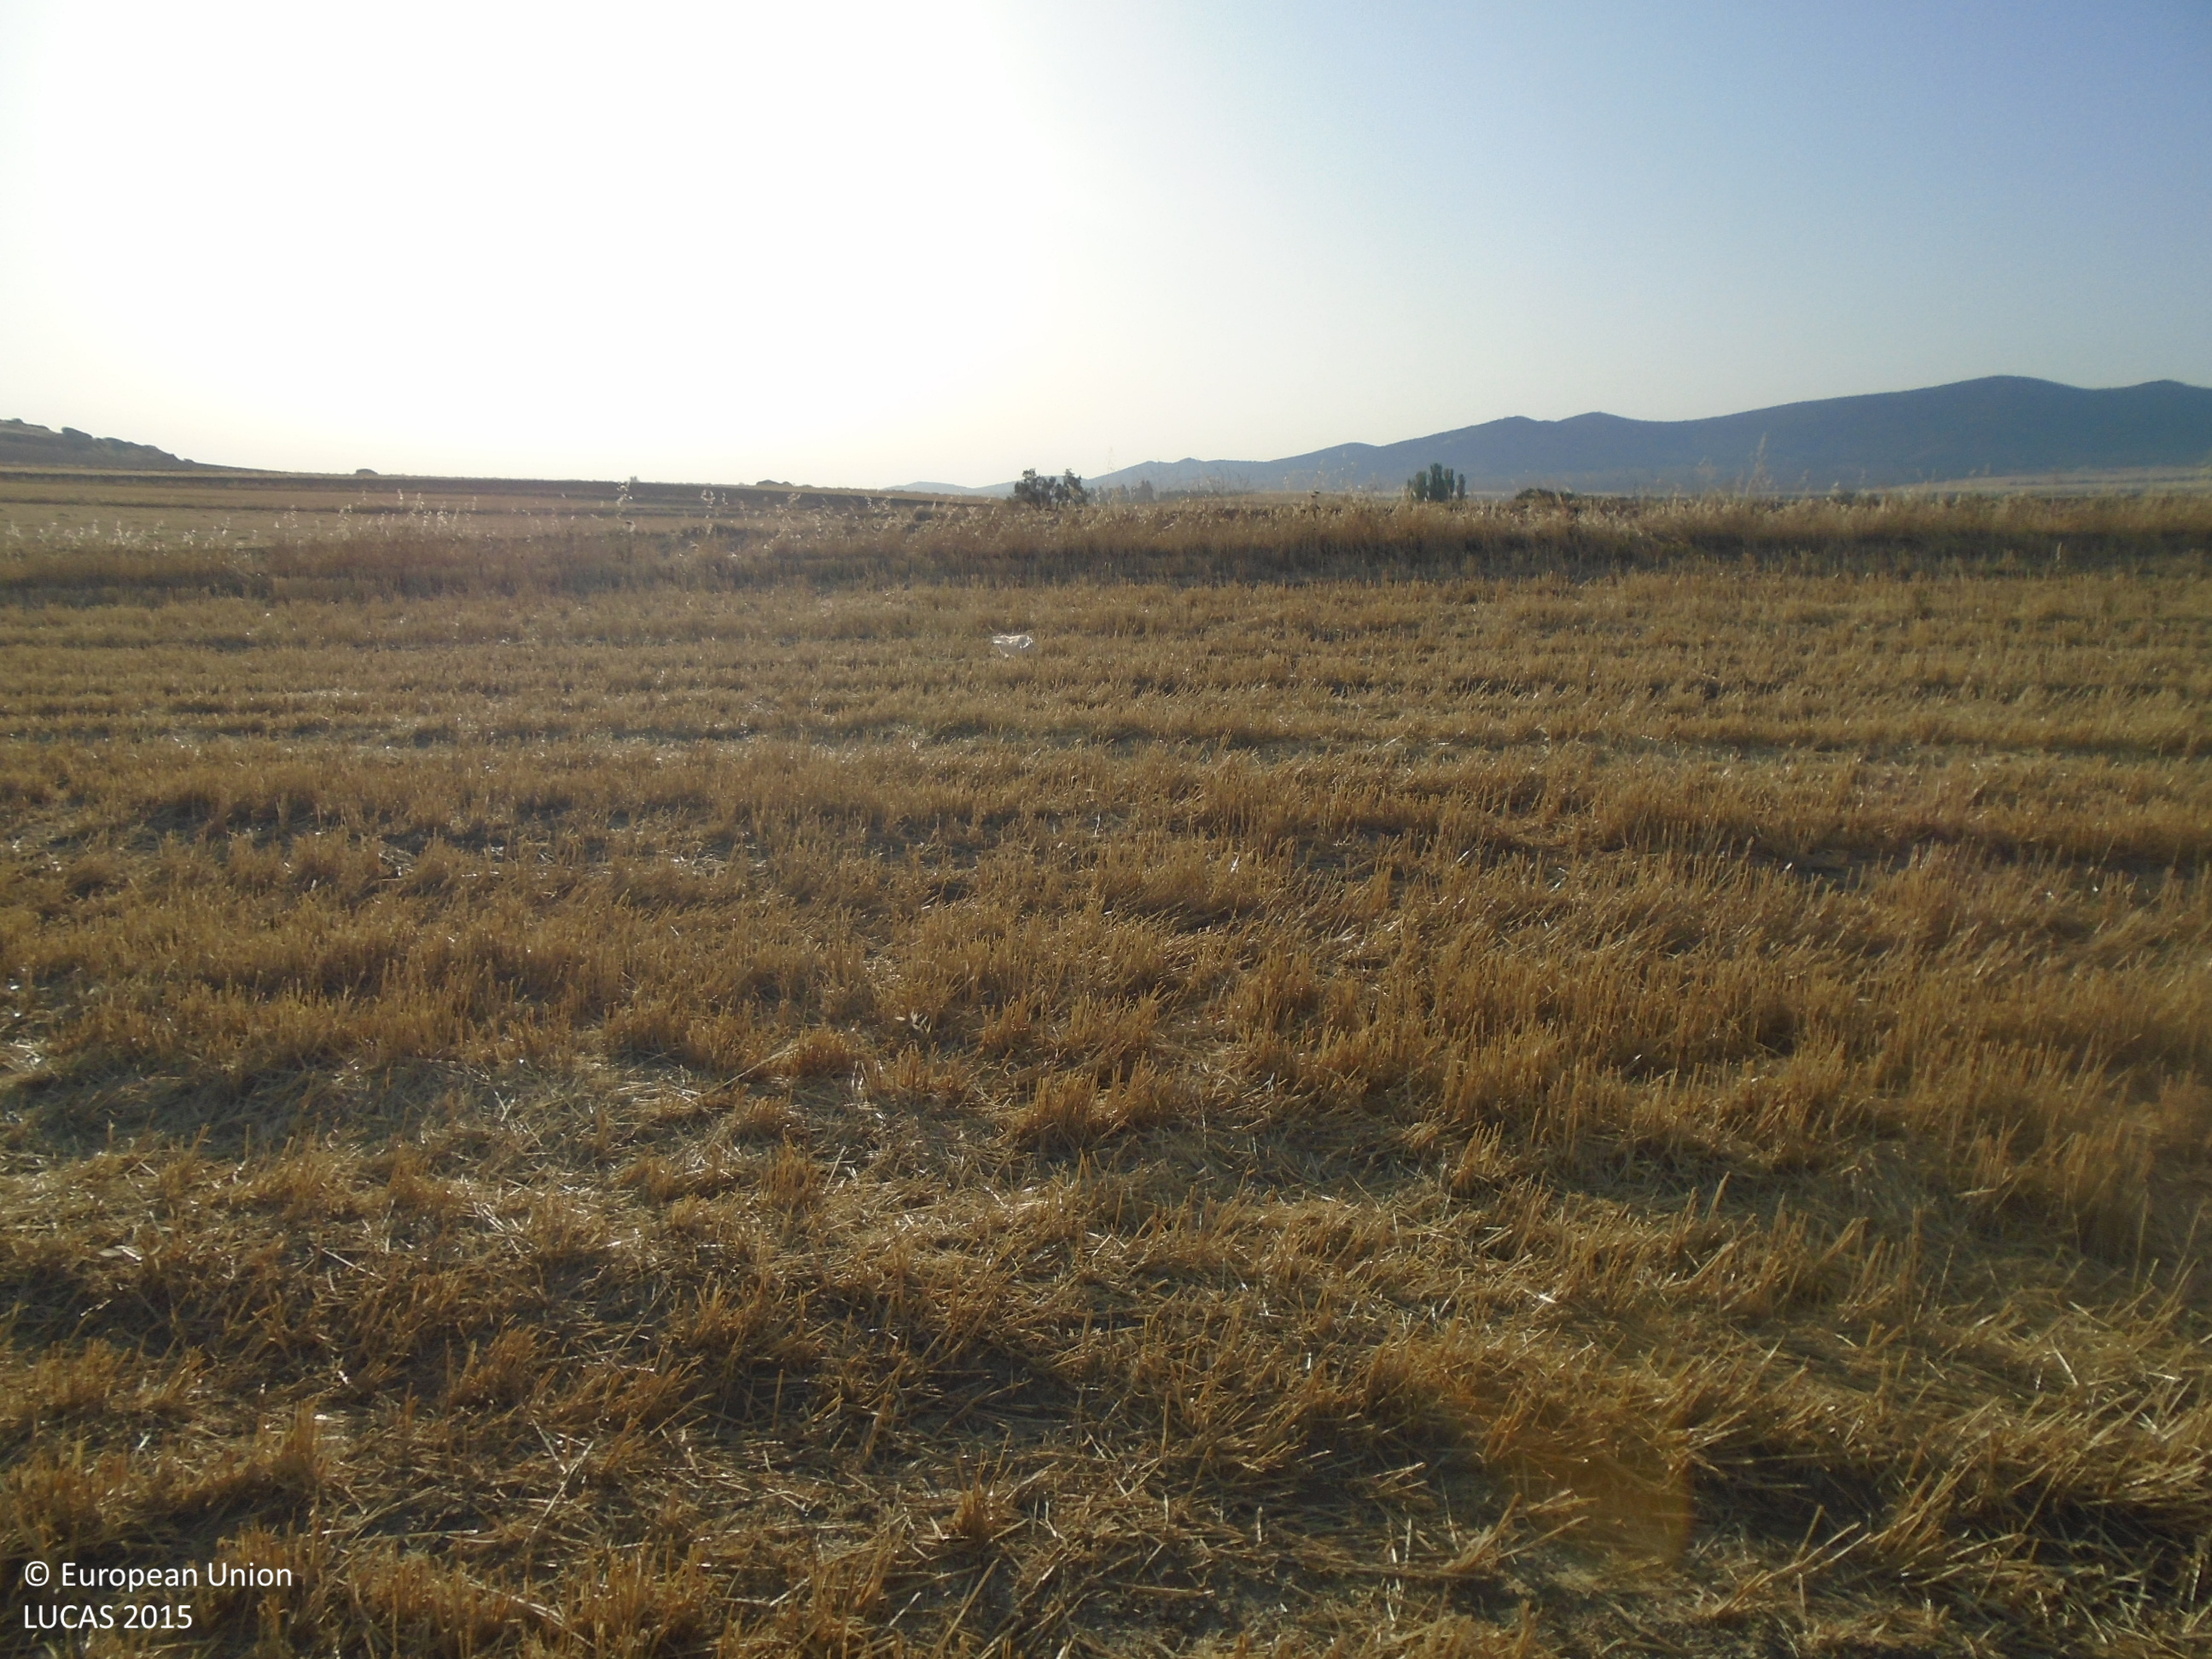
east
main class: Cropland
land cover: Barley
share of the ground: > 75 %
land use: Agriculture (excluding fallow land and kitchen gardens)
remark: Harvested field
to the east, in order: Barley; Grass margins; Other bare soil; Grass margins; Common wheat; Grass margins; Common wheat; Grassland without tree/shrub cover; Rivers and streams; Grass margins; Barley; Grass margins; Rivers and streams; Single bushes/trees; Barley; Grass margins; Tracks
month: July
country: ES
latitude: 39.3910
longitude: -3.7129
